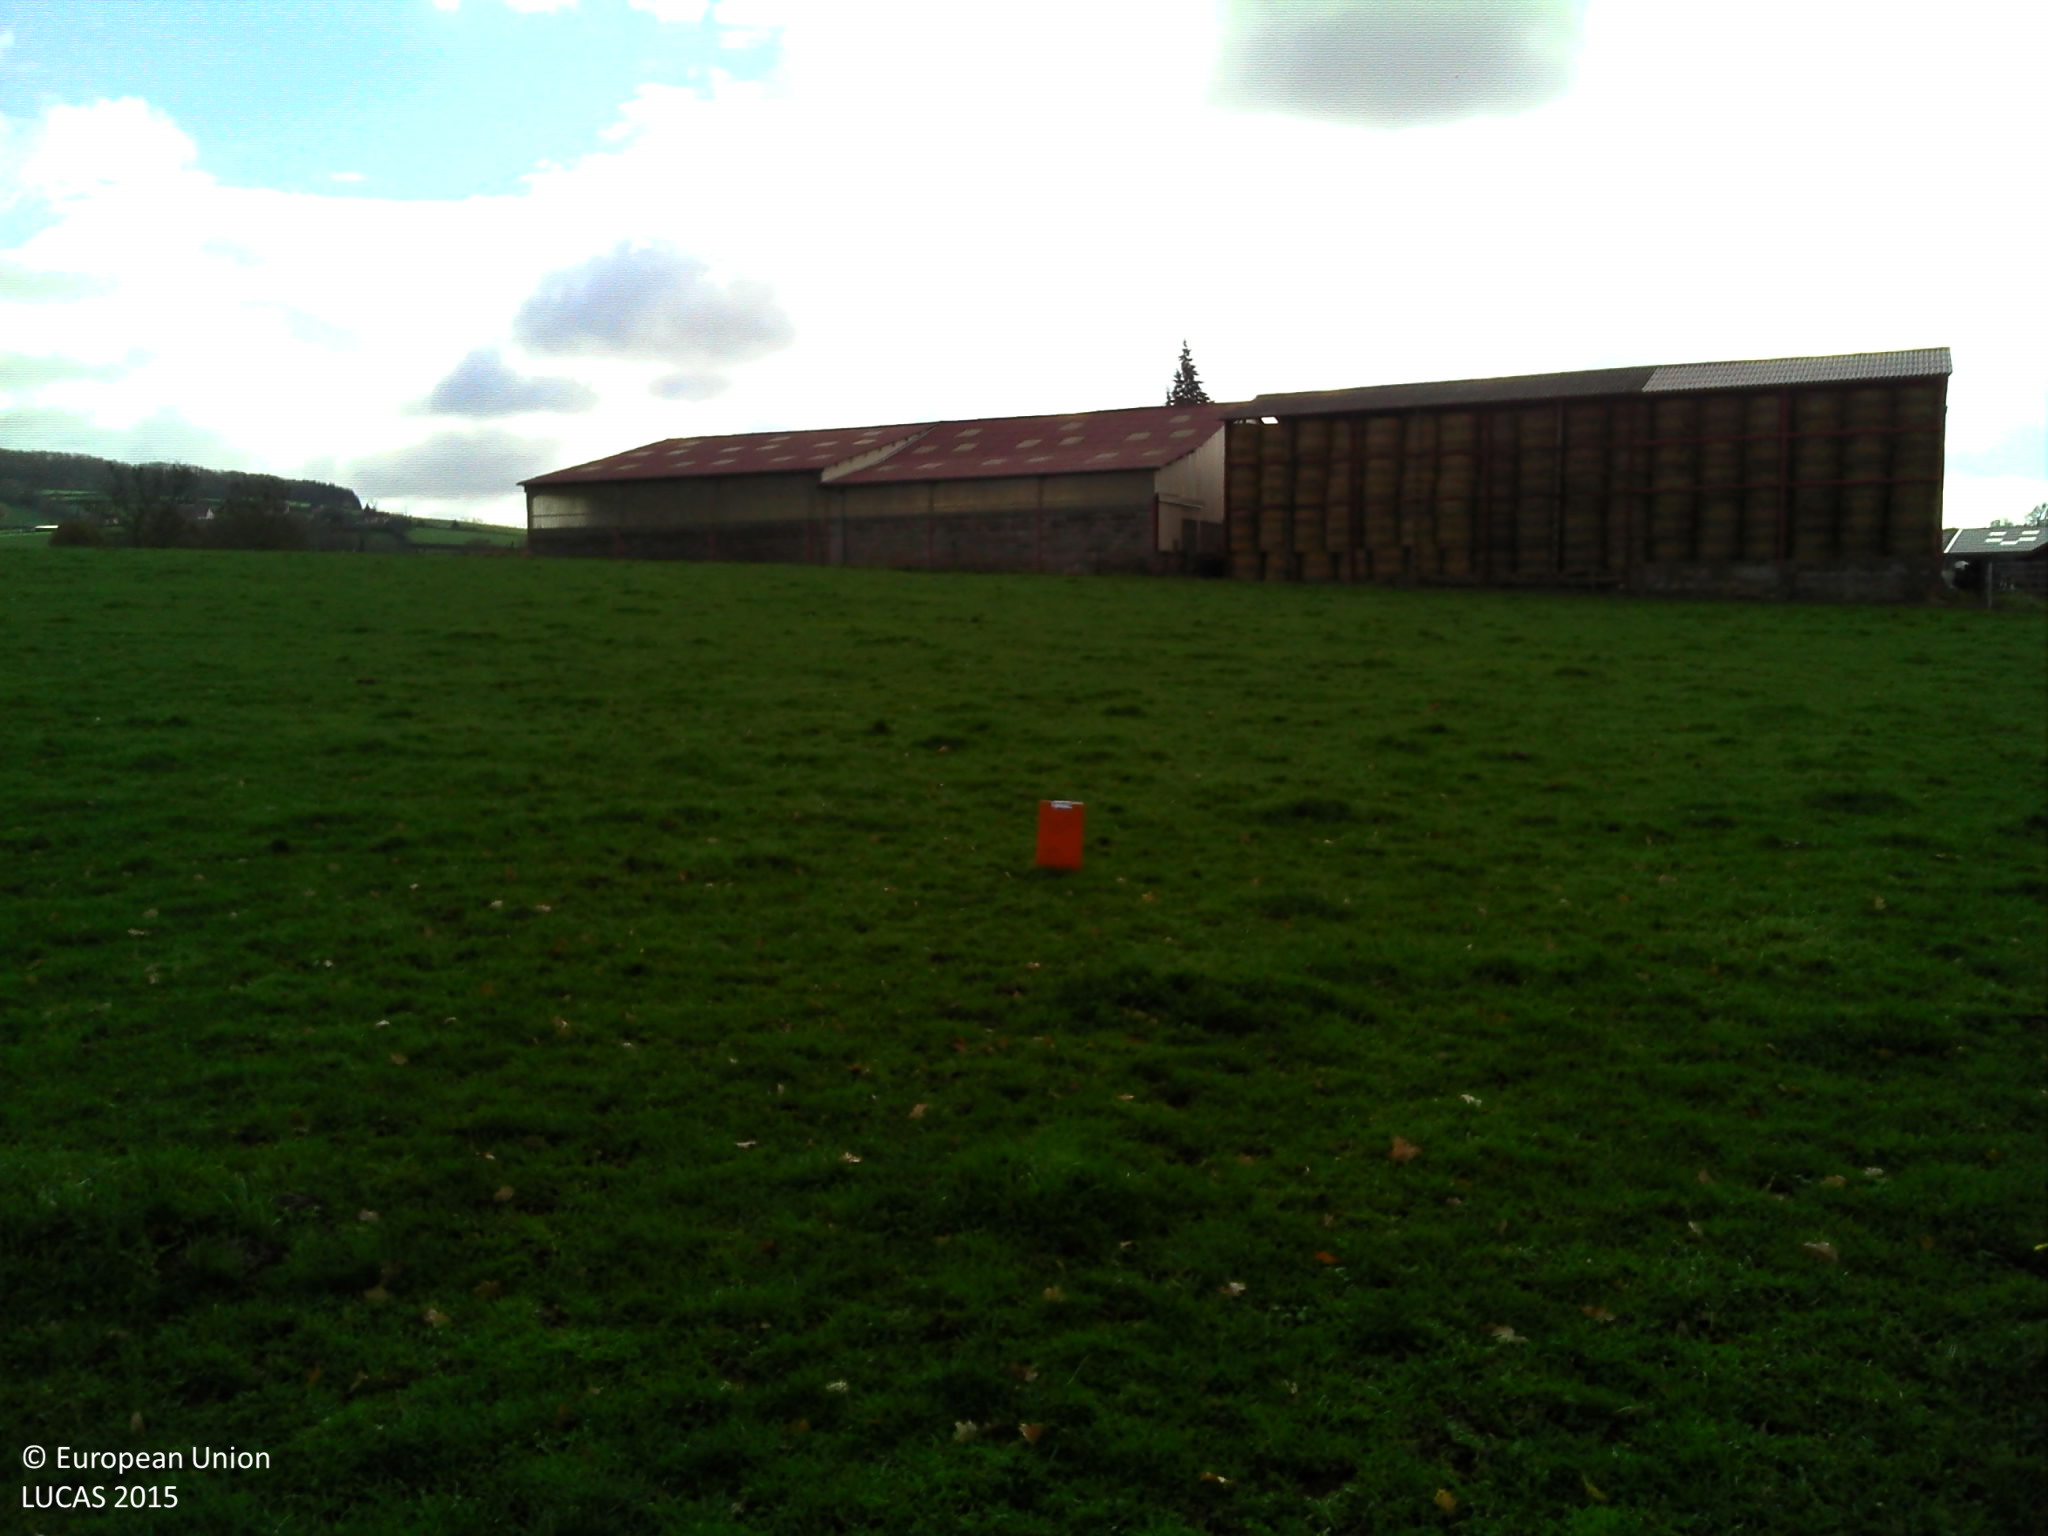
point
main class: Grassland
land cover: Grassland without tree/shrub cover
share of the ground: > 75 %
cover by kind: herbaceous plants 100 %
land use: Agriculture (excluding fallow land and kitchen gardens)
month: November
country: FR
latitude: 46.4177
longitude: 3.6895
